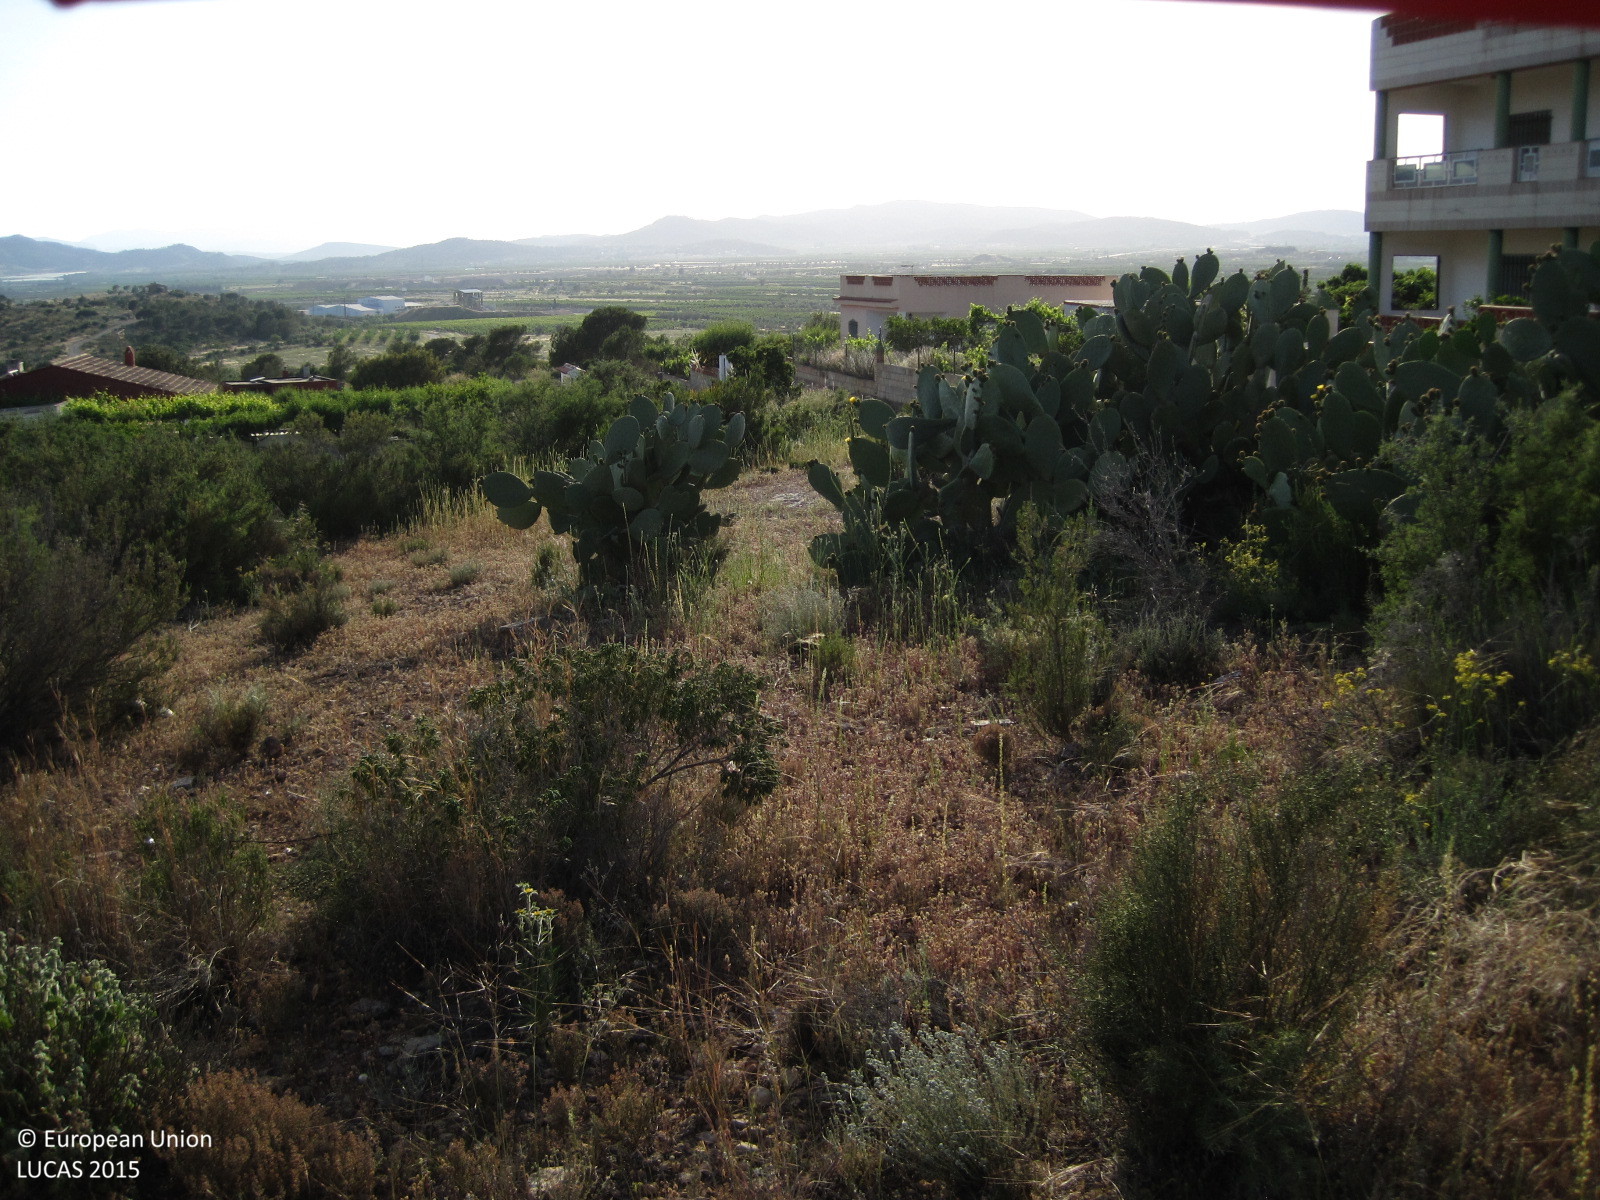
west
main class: Shrubland
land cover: Shrubland without tree cover
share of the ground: > 75 %
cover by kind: shrubs 80 %, consolidated bare surface 15 %, herbaceous plants 5 %
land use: Semi-natural and natural areas not in use
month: May
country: ES
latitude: 39.6838
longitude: -0.6696
